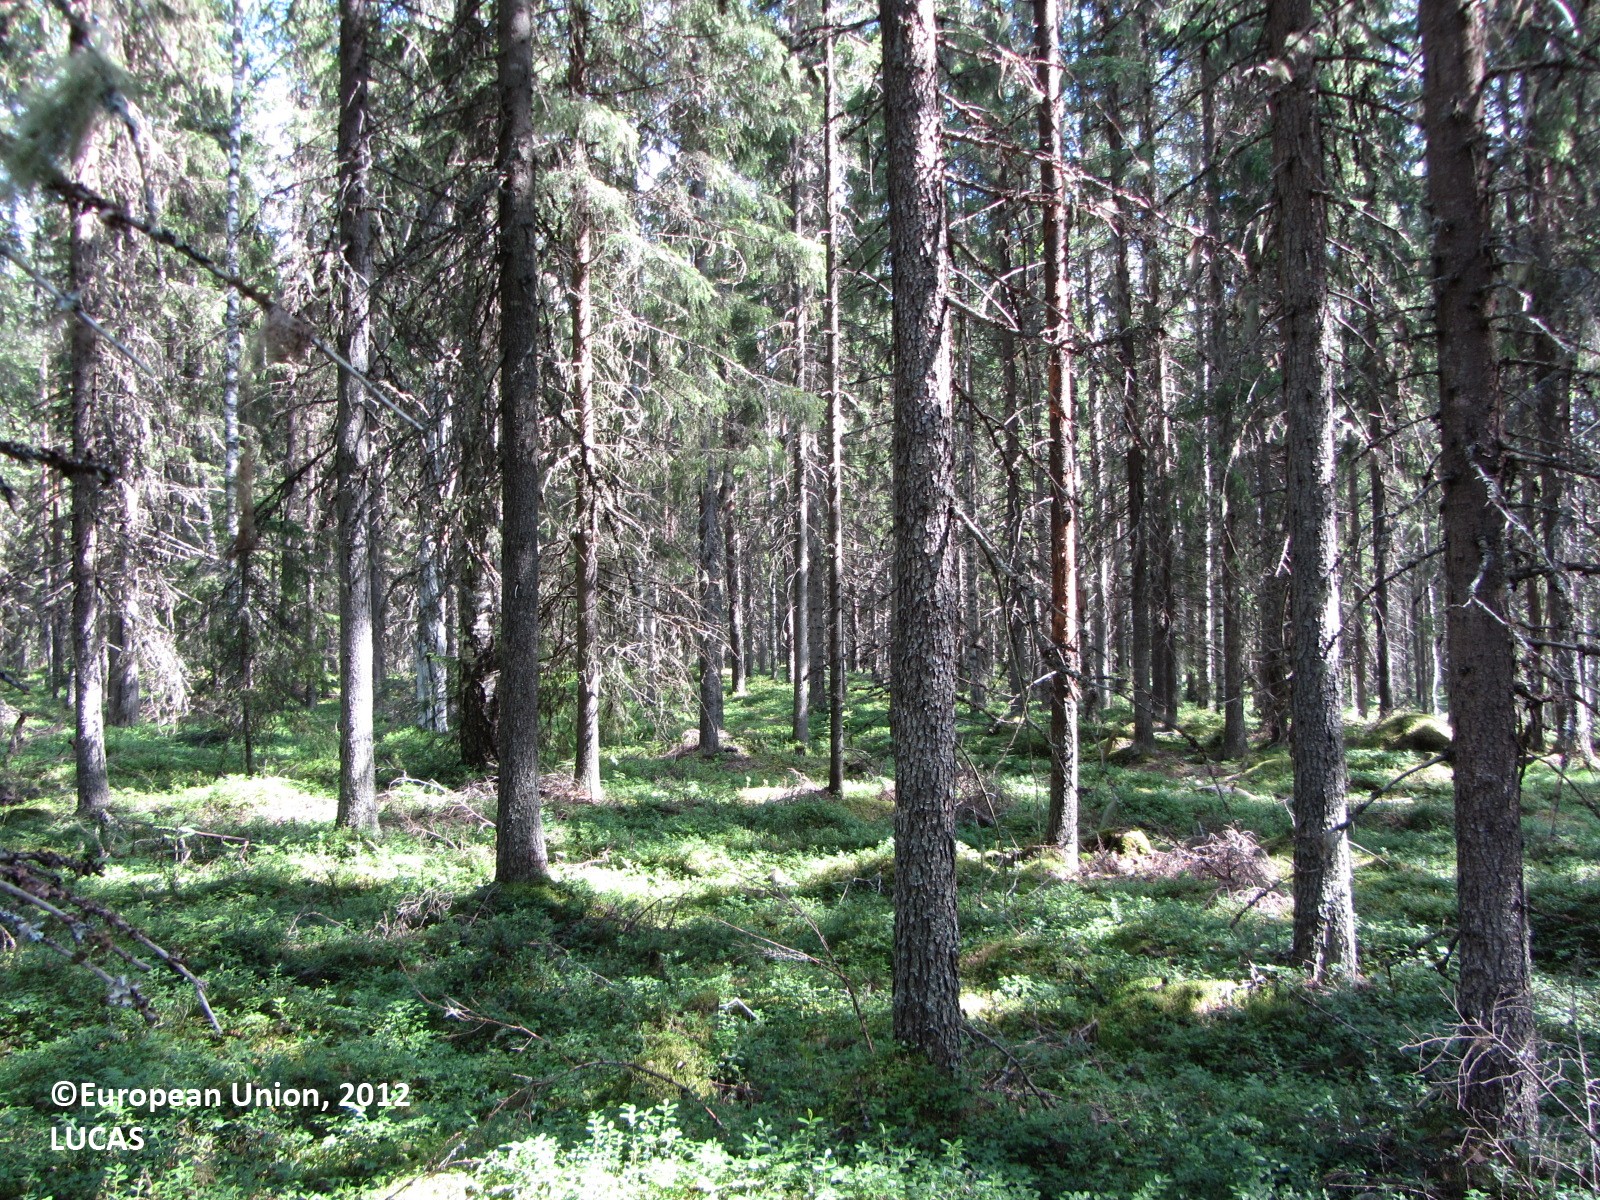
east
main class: Woodland
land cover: Spruce dominated coniferous woodland
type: boreal forest
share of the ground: > 75 %
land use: Forestry
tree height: > 5 m
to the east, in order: Spruce dominated coniferous woodland; Tracks; Spruce dominated coniferous woodland; Tracks; Other coniferous woodland; Spruce dominated coniferous woodland
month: July
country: FI
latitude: 63.5492
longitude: 24.6305
